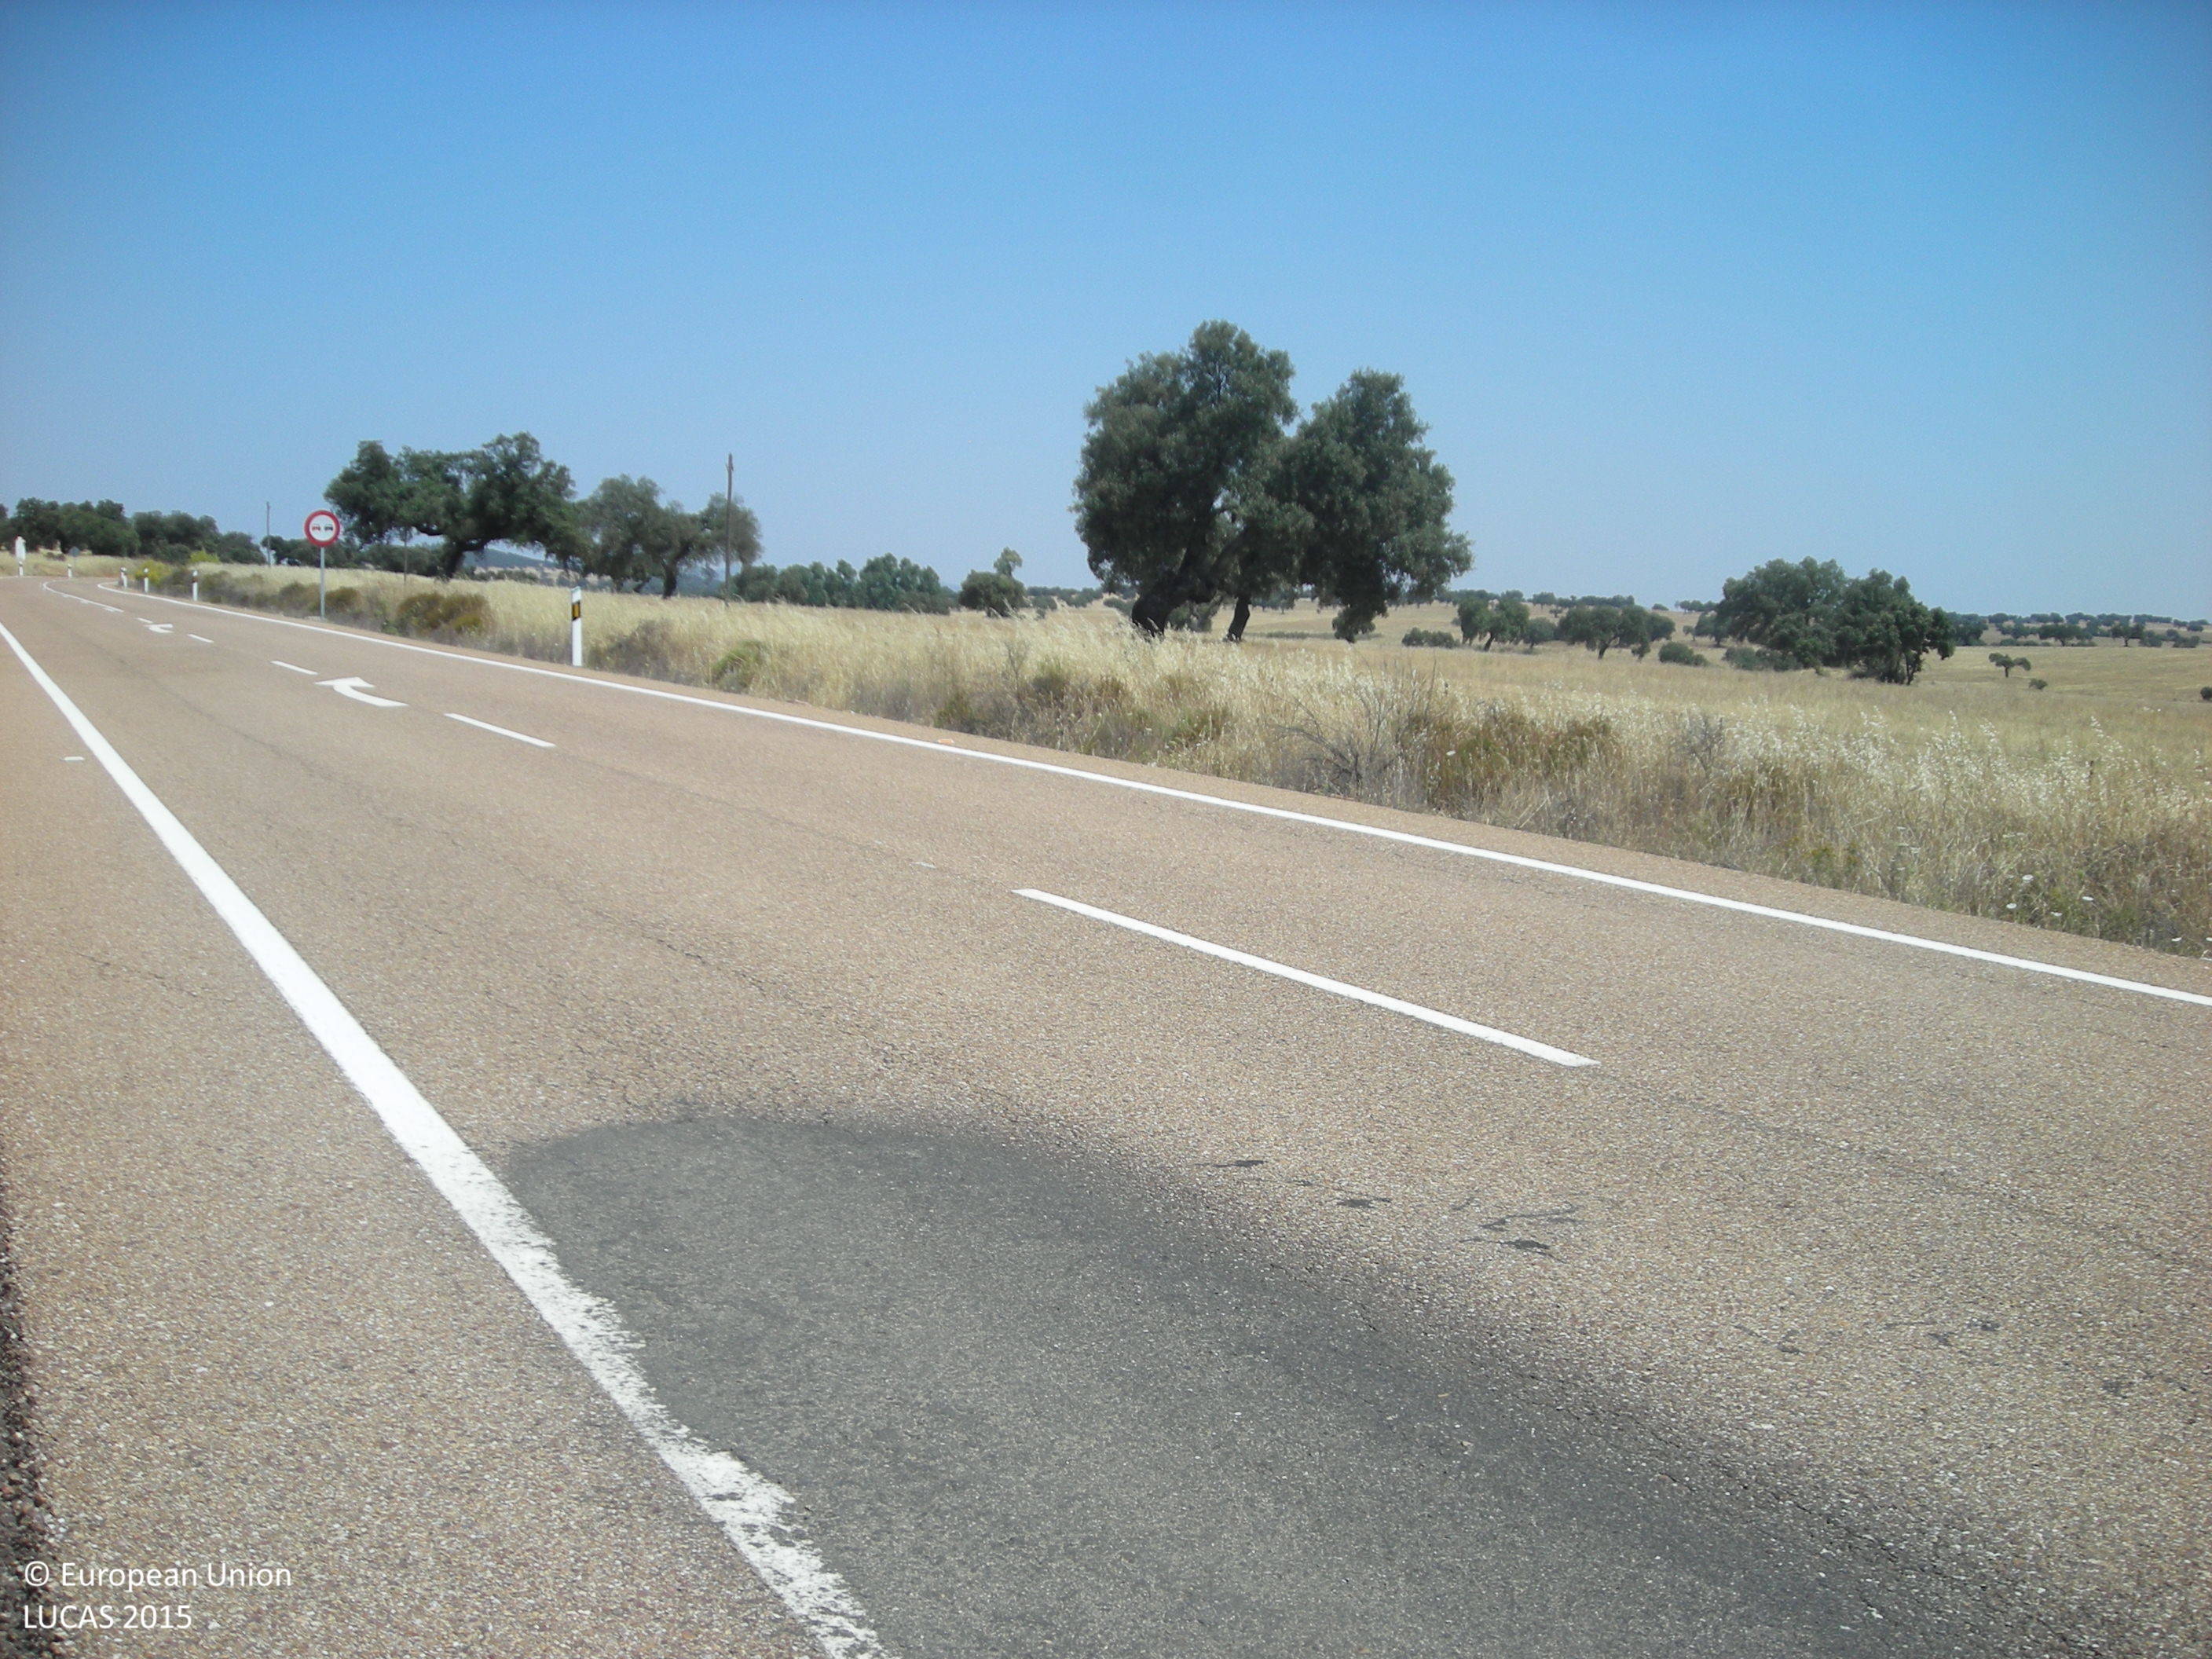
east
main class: Shrubland
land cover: Shrubland without tree cover
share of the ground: > 75 %
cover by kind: shrubs 100 %
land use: Semi-natural and natural areas not in use
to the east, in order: Shrubland without tree cover; Broadleaved woodland
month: June
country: ES
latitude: 38.6501
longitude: -5.8897
